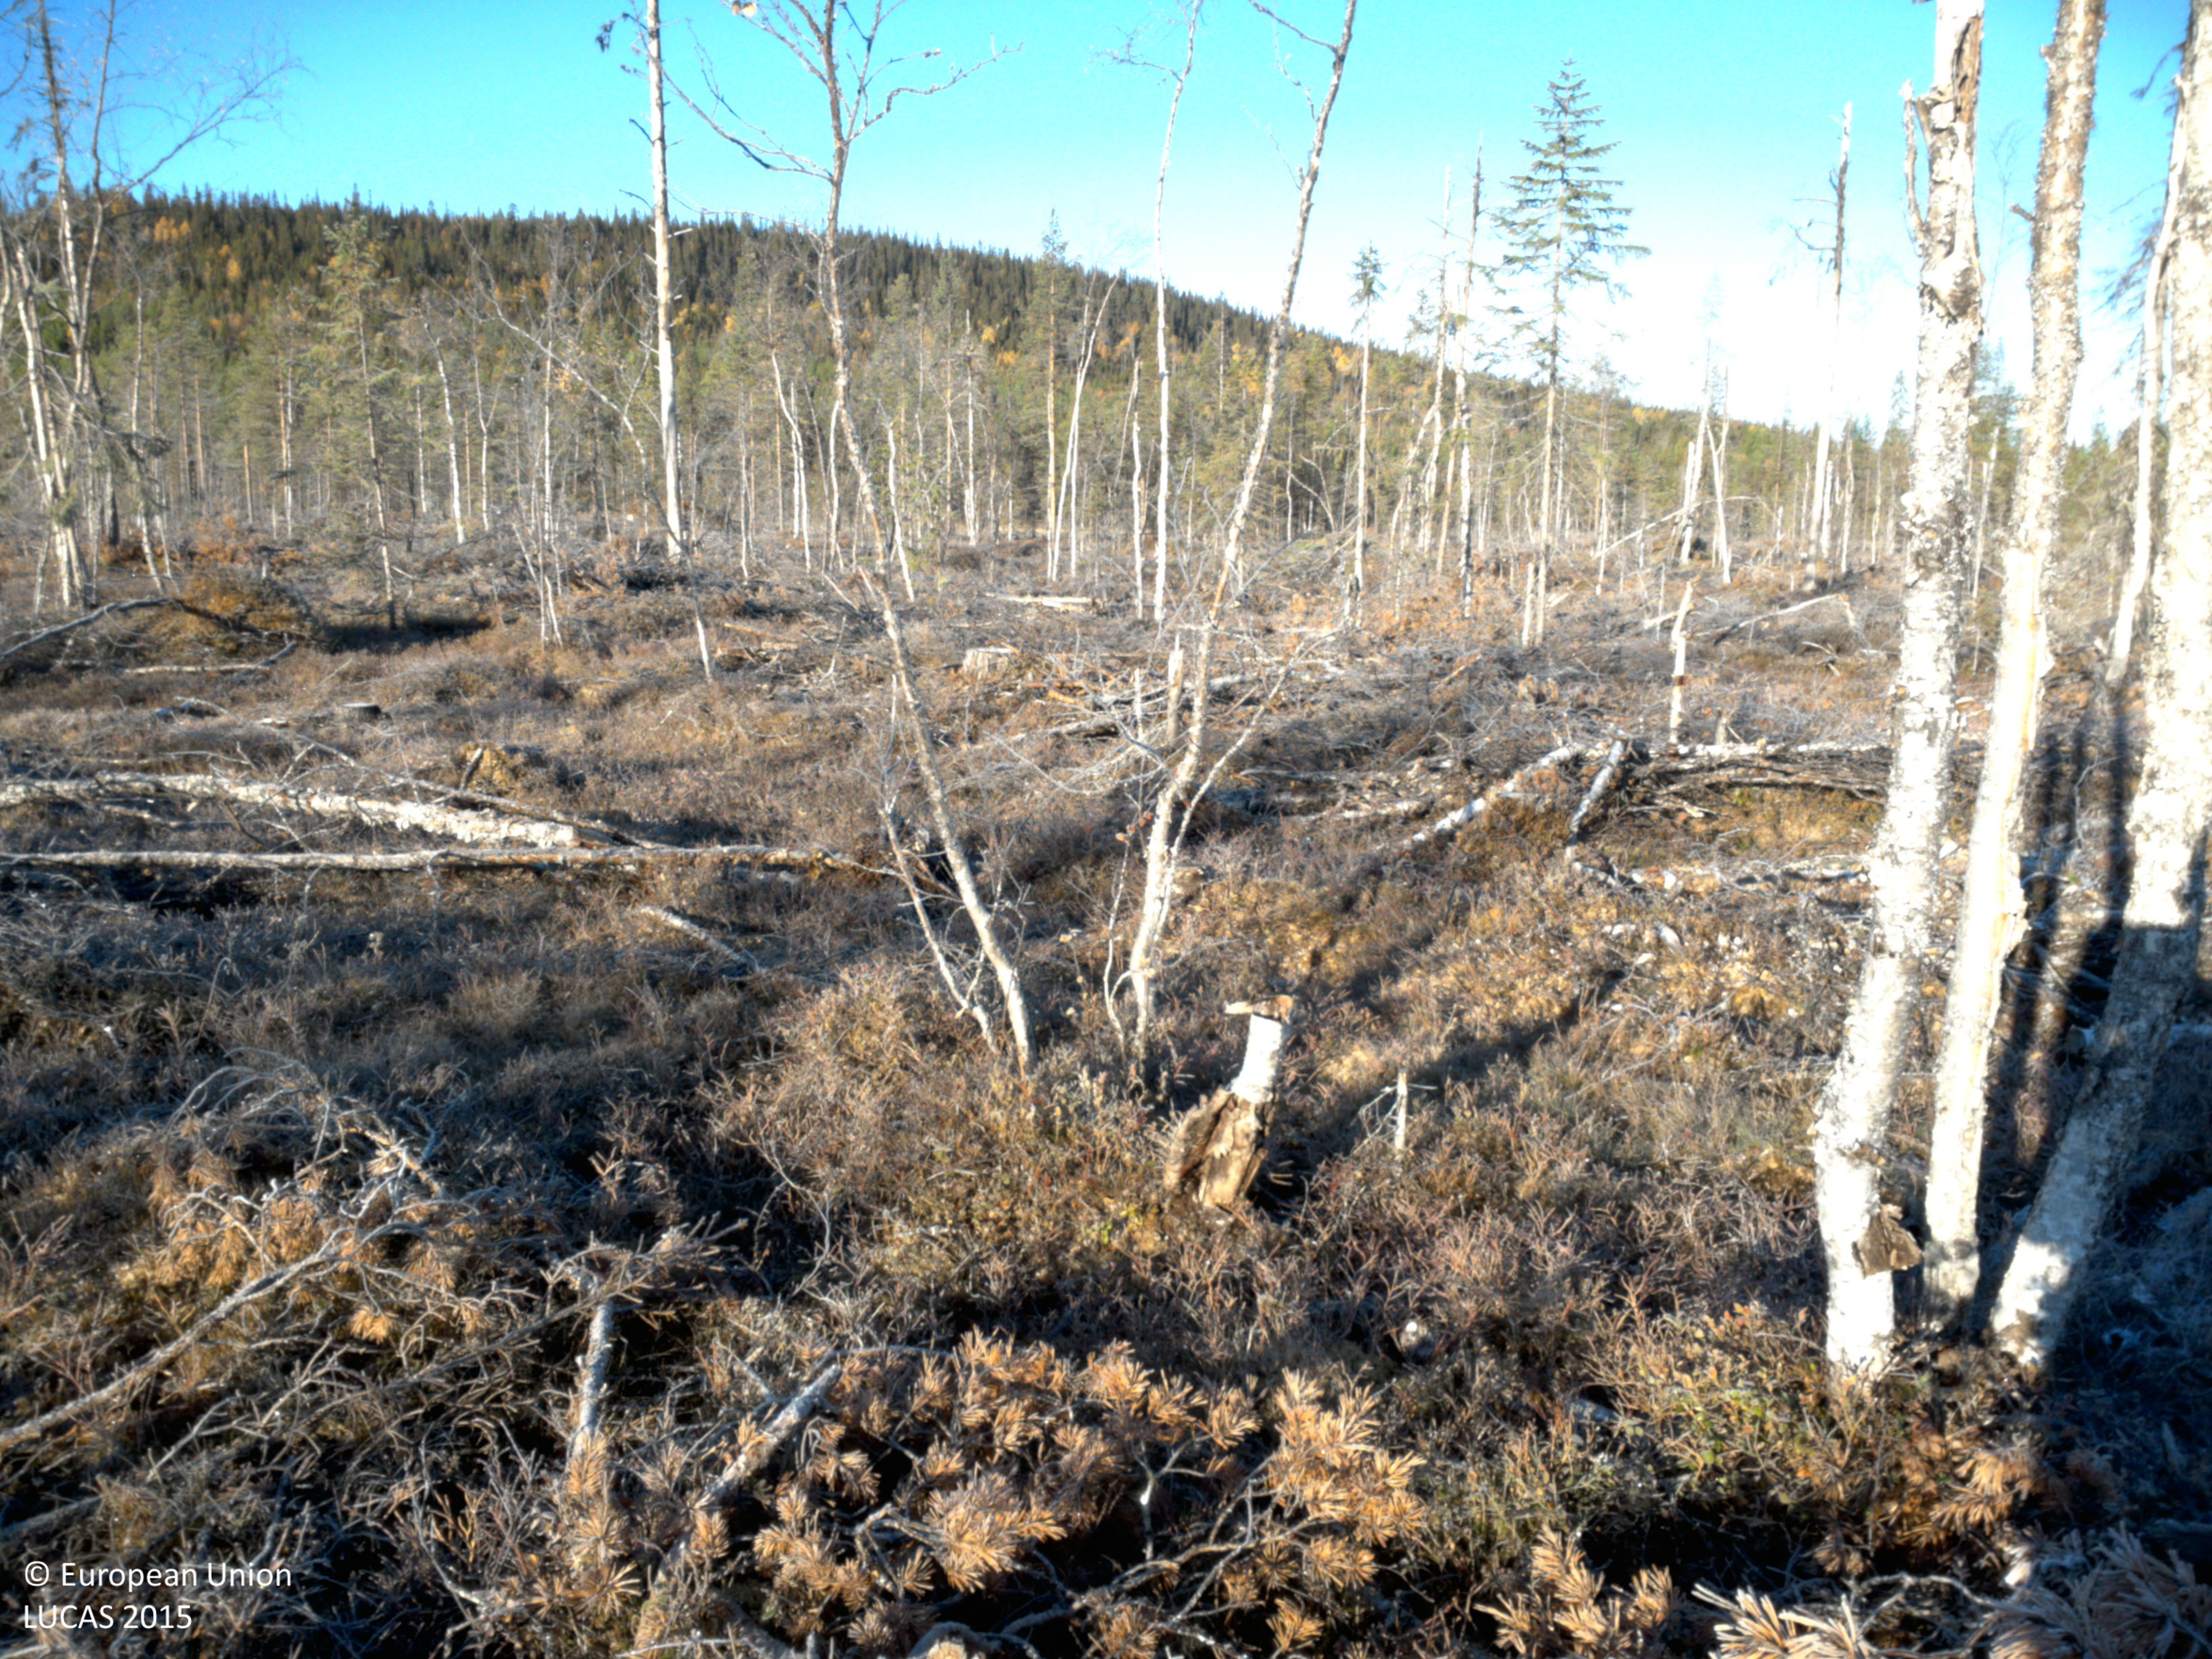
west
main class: Shrubland
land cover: Shrubland with sparse tree cover
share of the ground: 10 - 25 %
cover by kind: shrubs 10 %, coniferous forest trees 5 %
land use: Forestry
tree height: < 5 m
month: October
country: SE
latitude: 64.7331
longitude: 17.7976
